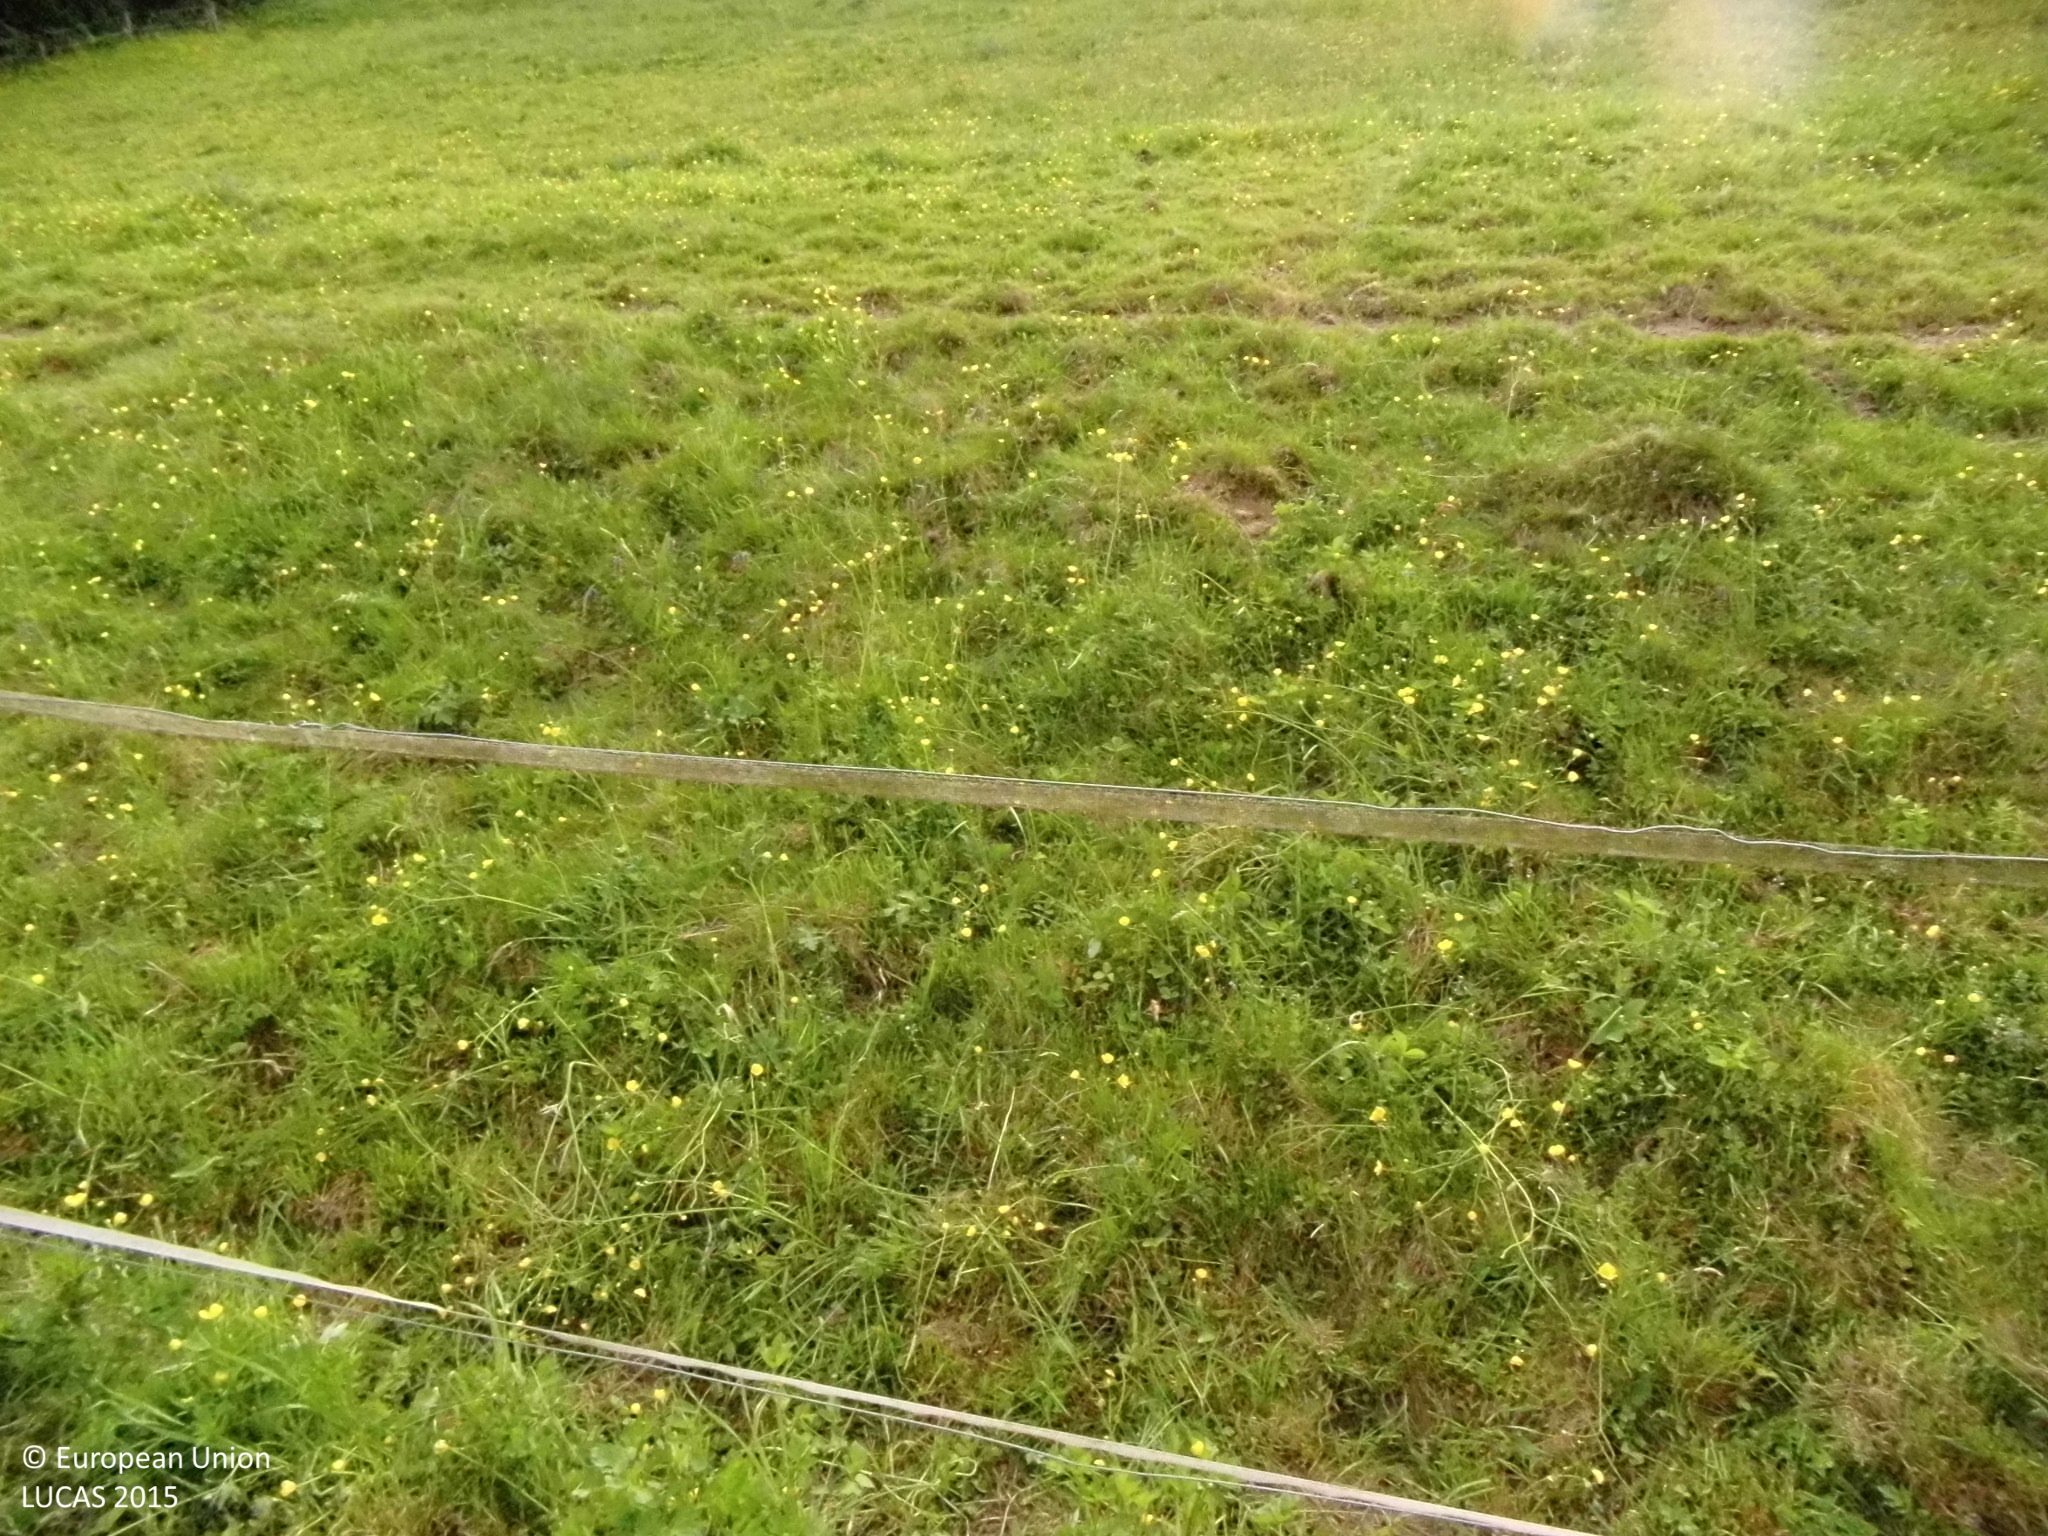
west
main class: Grassland
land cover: Grassland without tree/shrub cover
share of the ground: > 75 %
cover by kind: herbaceous plants 100 %
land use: Agriculture (excluding fallow land and kitchen gardens)
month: May
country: DE
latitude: 50.5886
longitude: 7.5001
